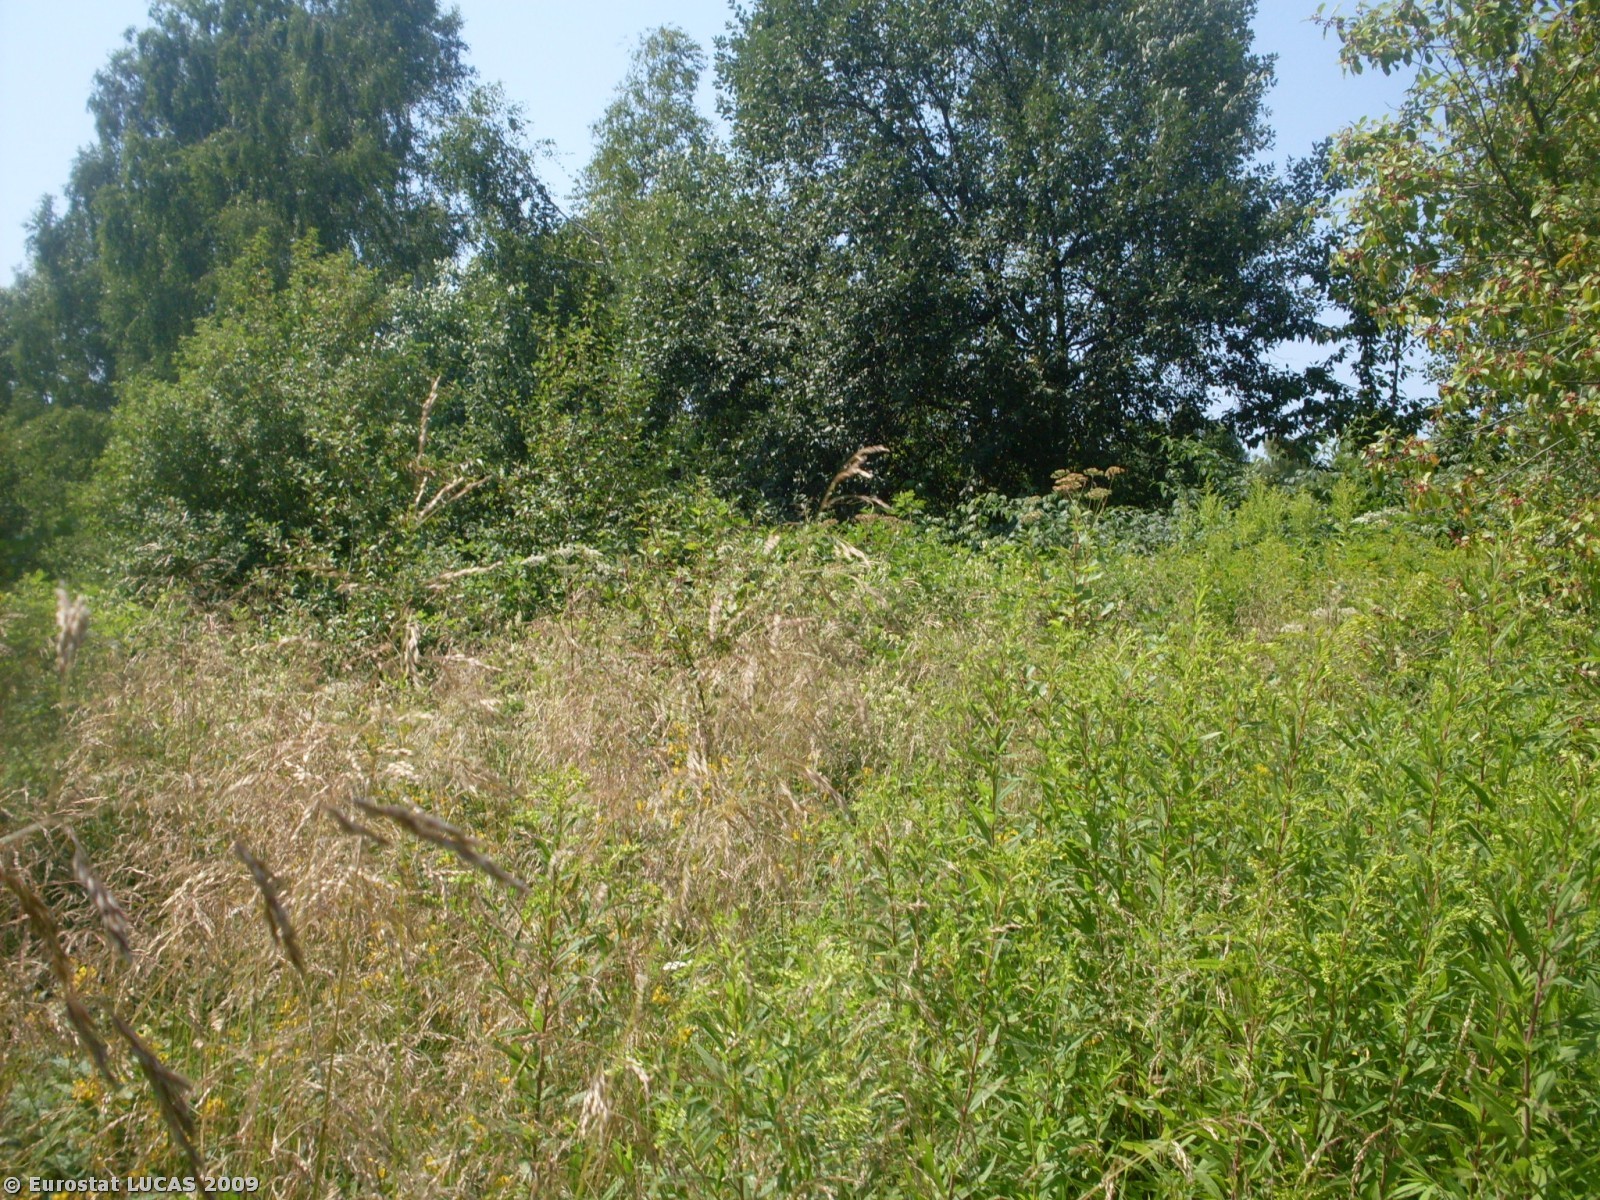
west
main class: Grassland
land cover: Grassland with sparse tree/shrub cover
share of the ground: > 75 %
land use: Unused
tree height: > 5 m
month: August
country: PL
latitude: 49.9083
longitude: 20.5793
